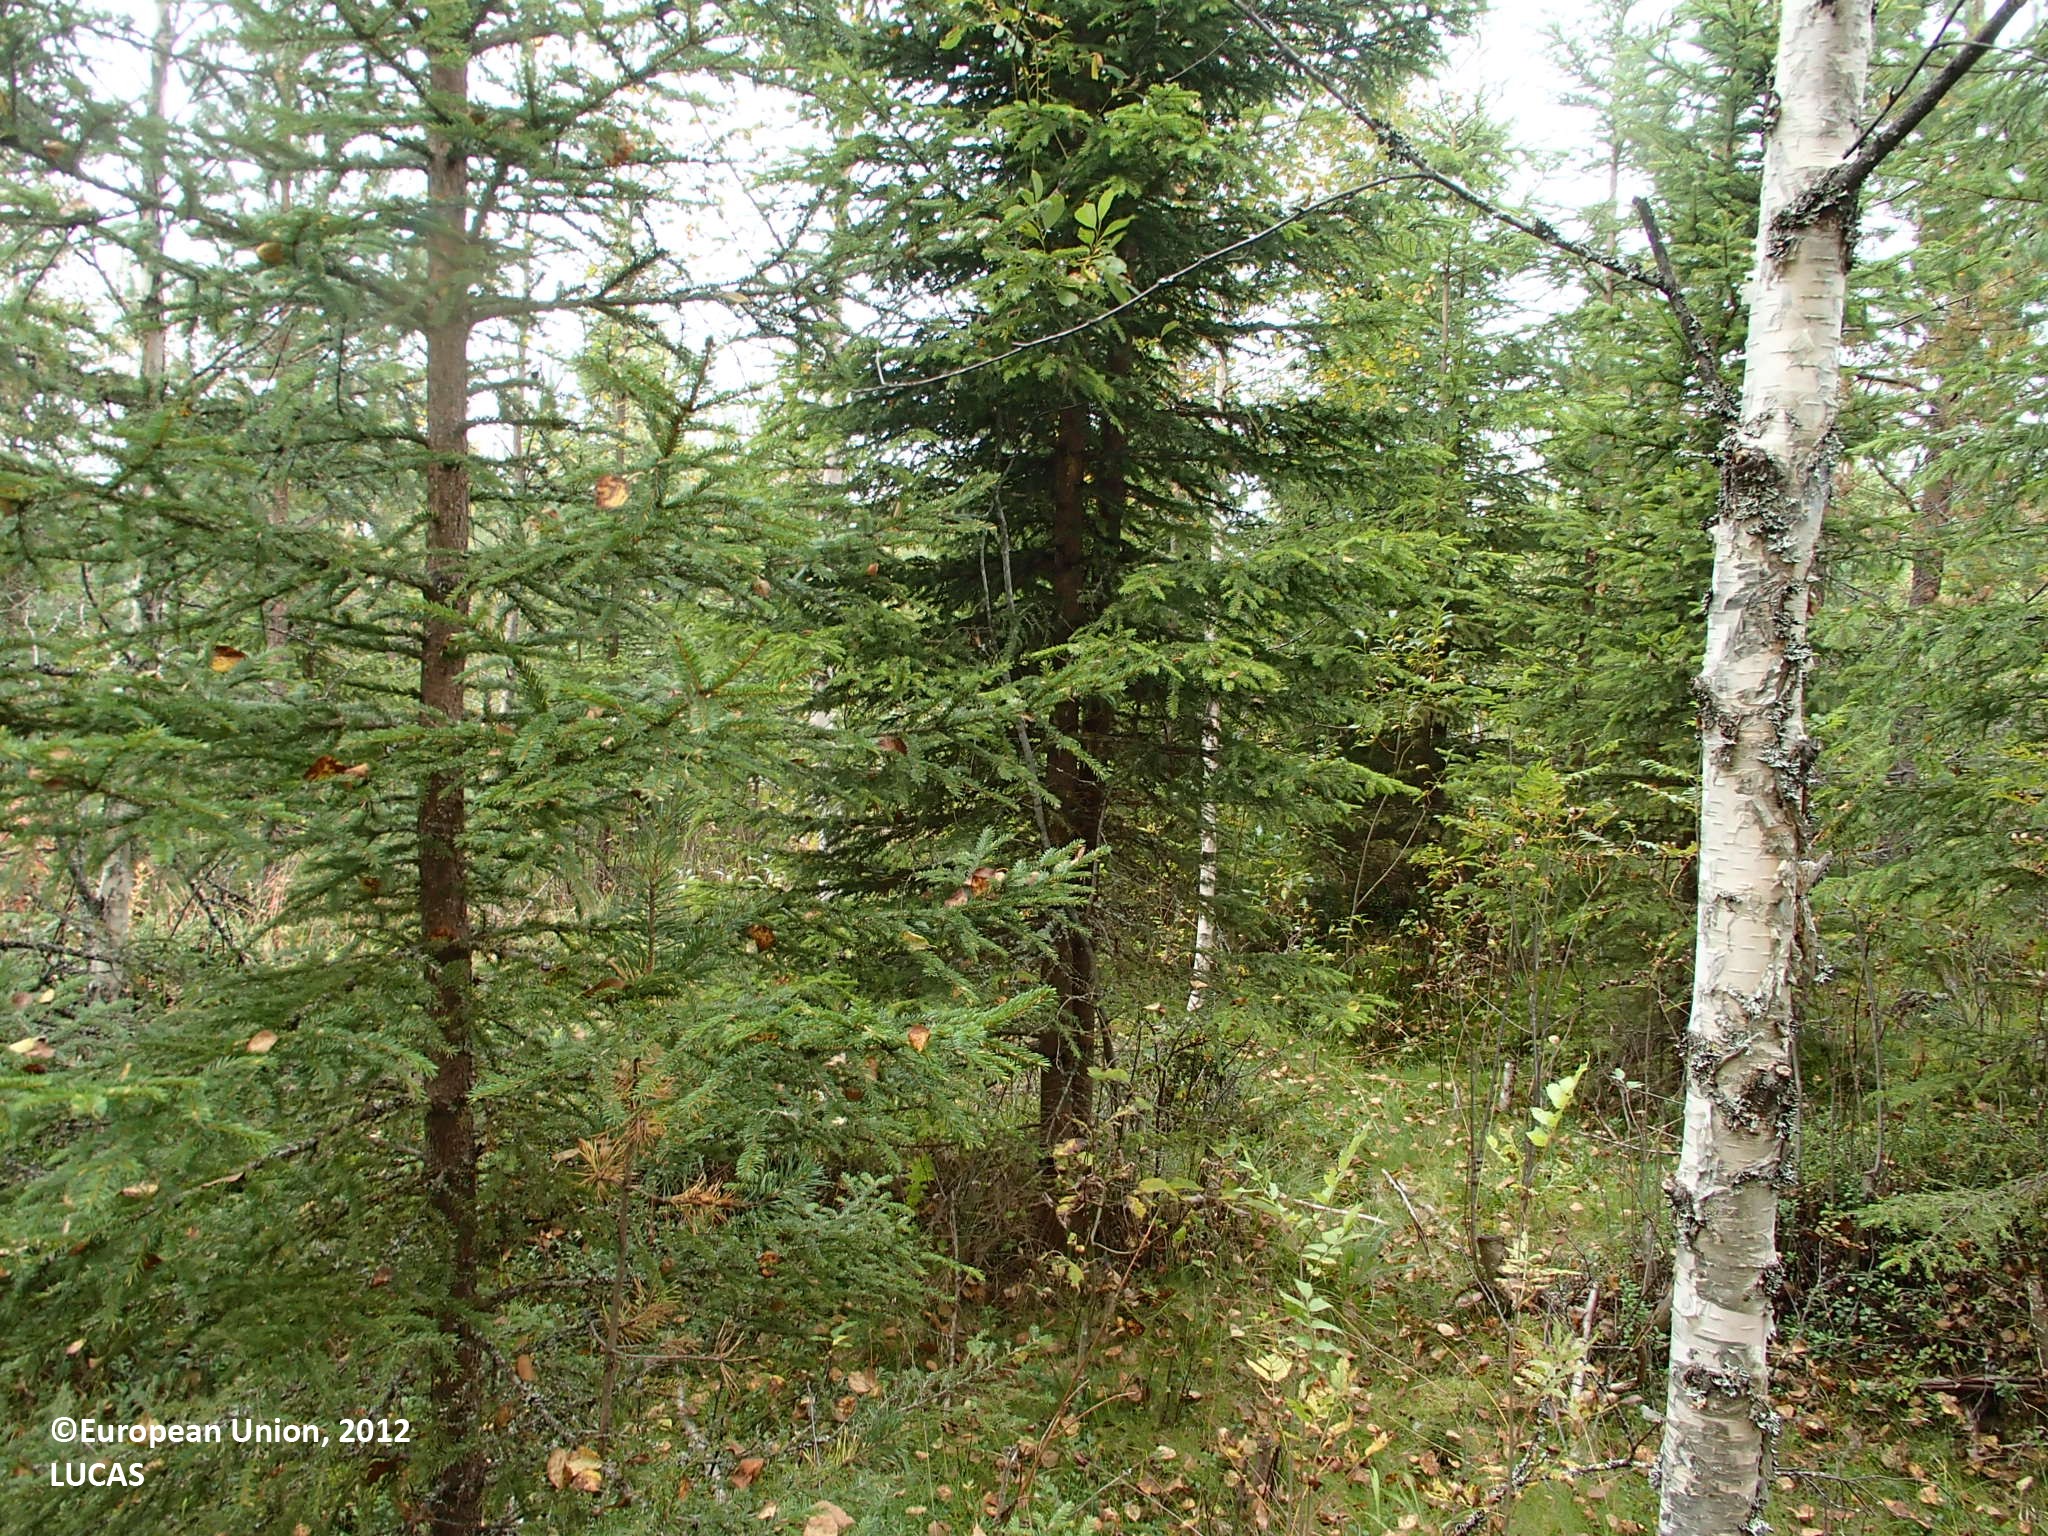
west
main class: Woodland
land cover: Other mixed woodland
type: boreal forest
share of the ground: > 75 %
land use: Forestry
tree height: > 5 m
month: September
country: FI
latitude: 63.8214
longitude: 25.9763
